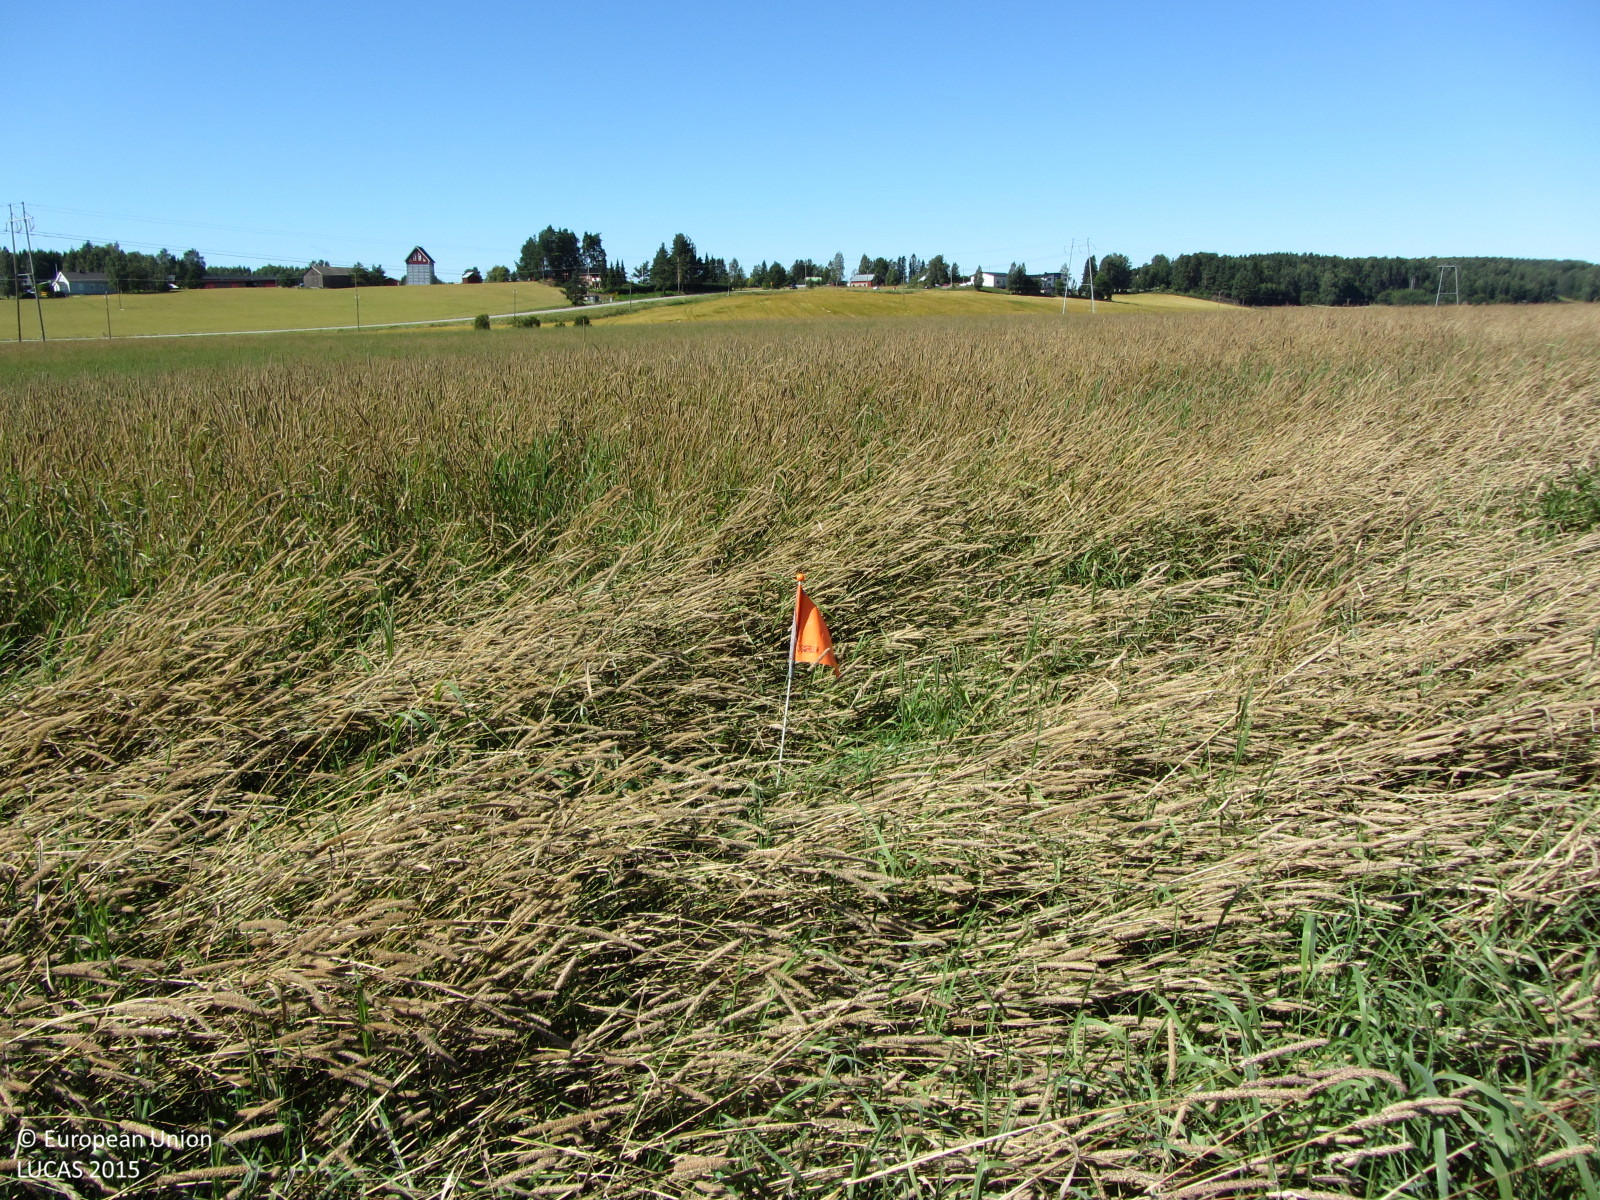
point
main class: Grassland
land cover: Spontaneously vegetated surfaces
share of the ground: > 75 %
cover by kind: herbaceous plants 100 %
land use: Fallow land
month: August
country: FI
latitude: 60.4524
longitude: 23.9663
